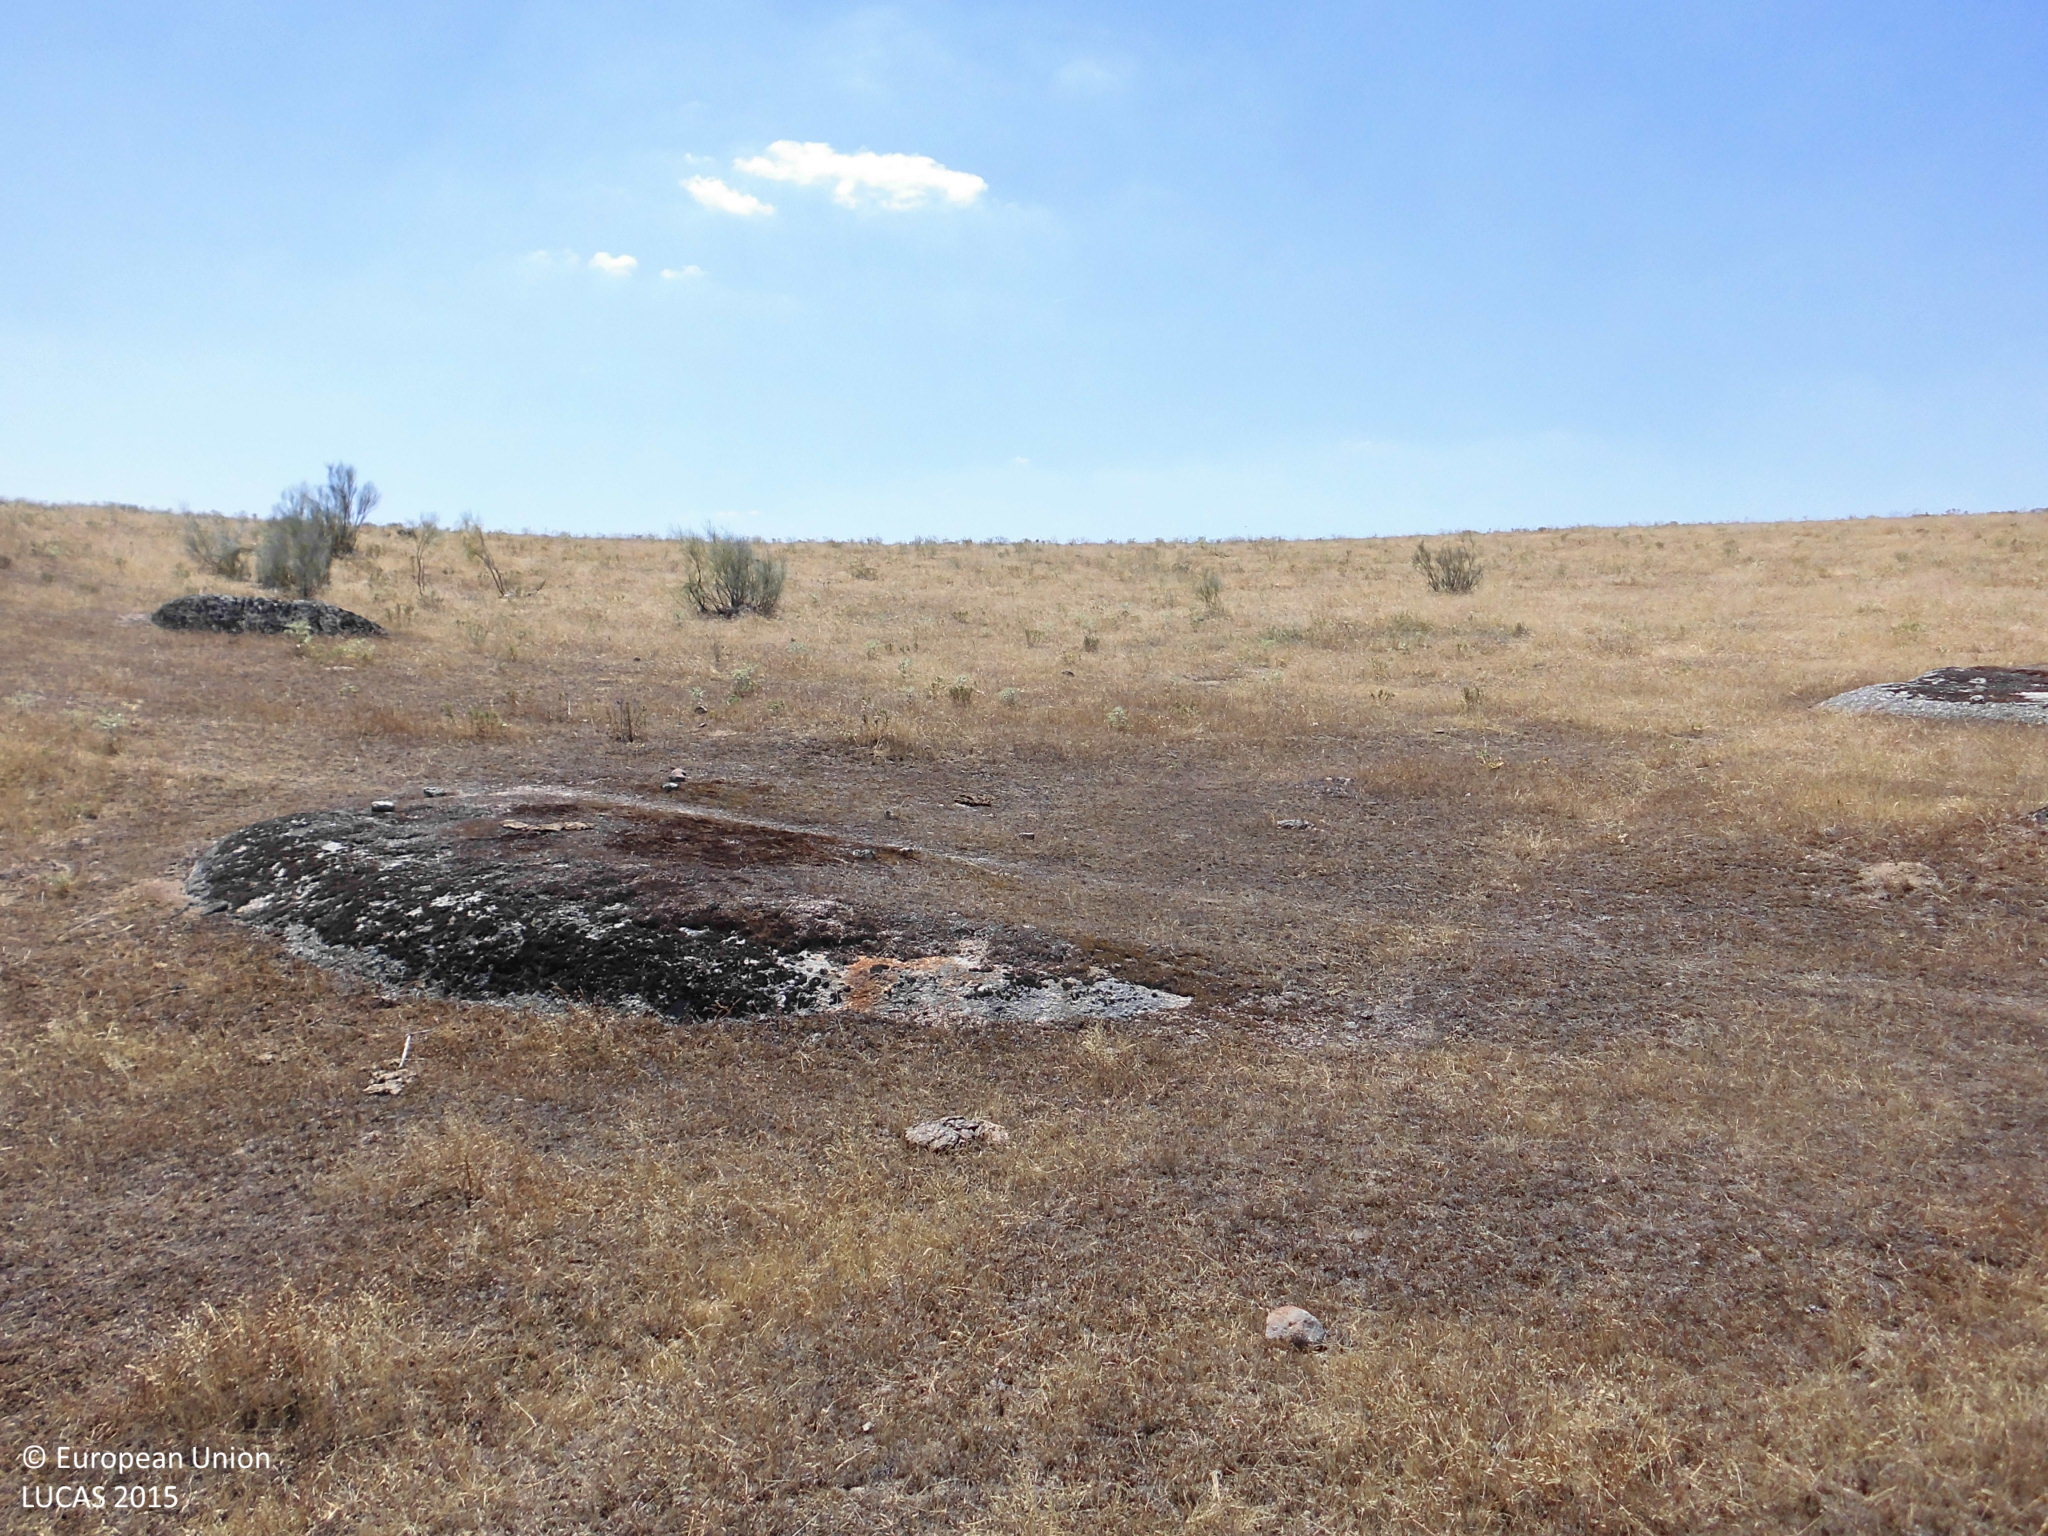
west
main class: Grassland
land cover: Grassland without tree/shrub cover
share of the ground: 25 - 50 %
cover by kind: consolidated bare surface 60 %, herbaceous plants 40 %
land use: Agriculture (excluding fallow land and kitchen gardens)
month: June
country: ES
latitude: 39.6074
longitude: -6.4354
